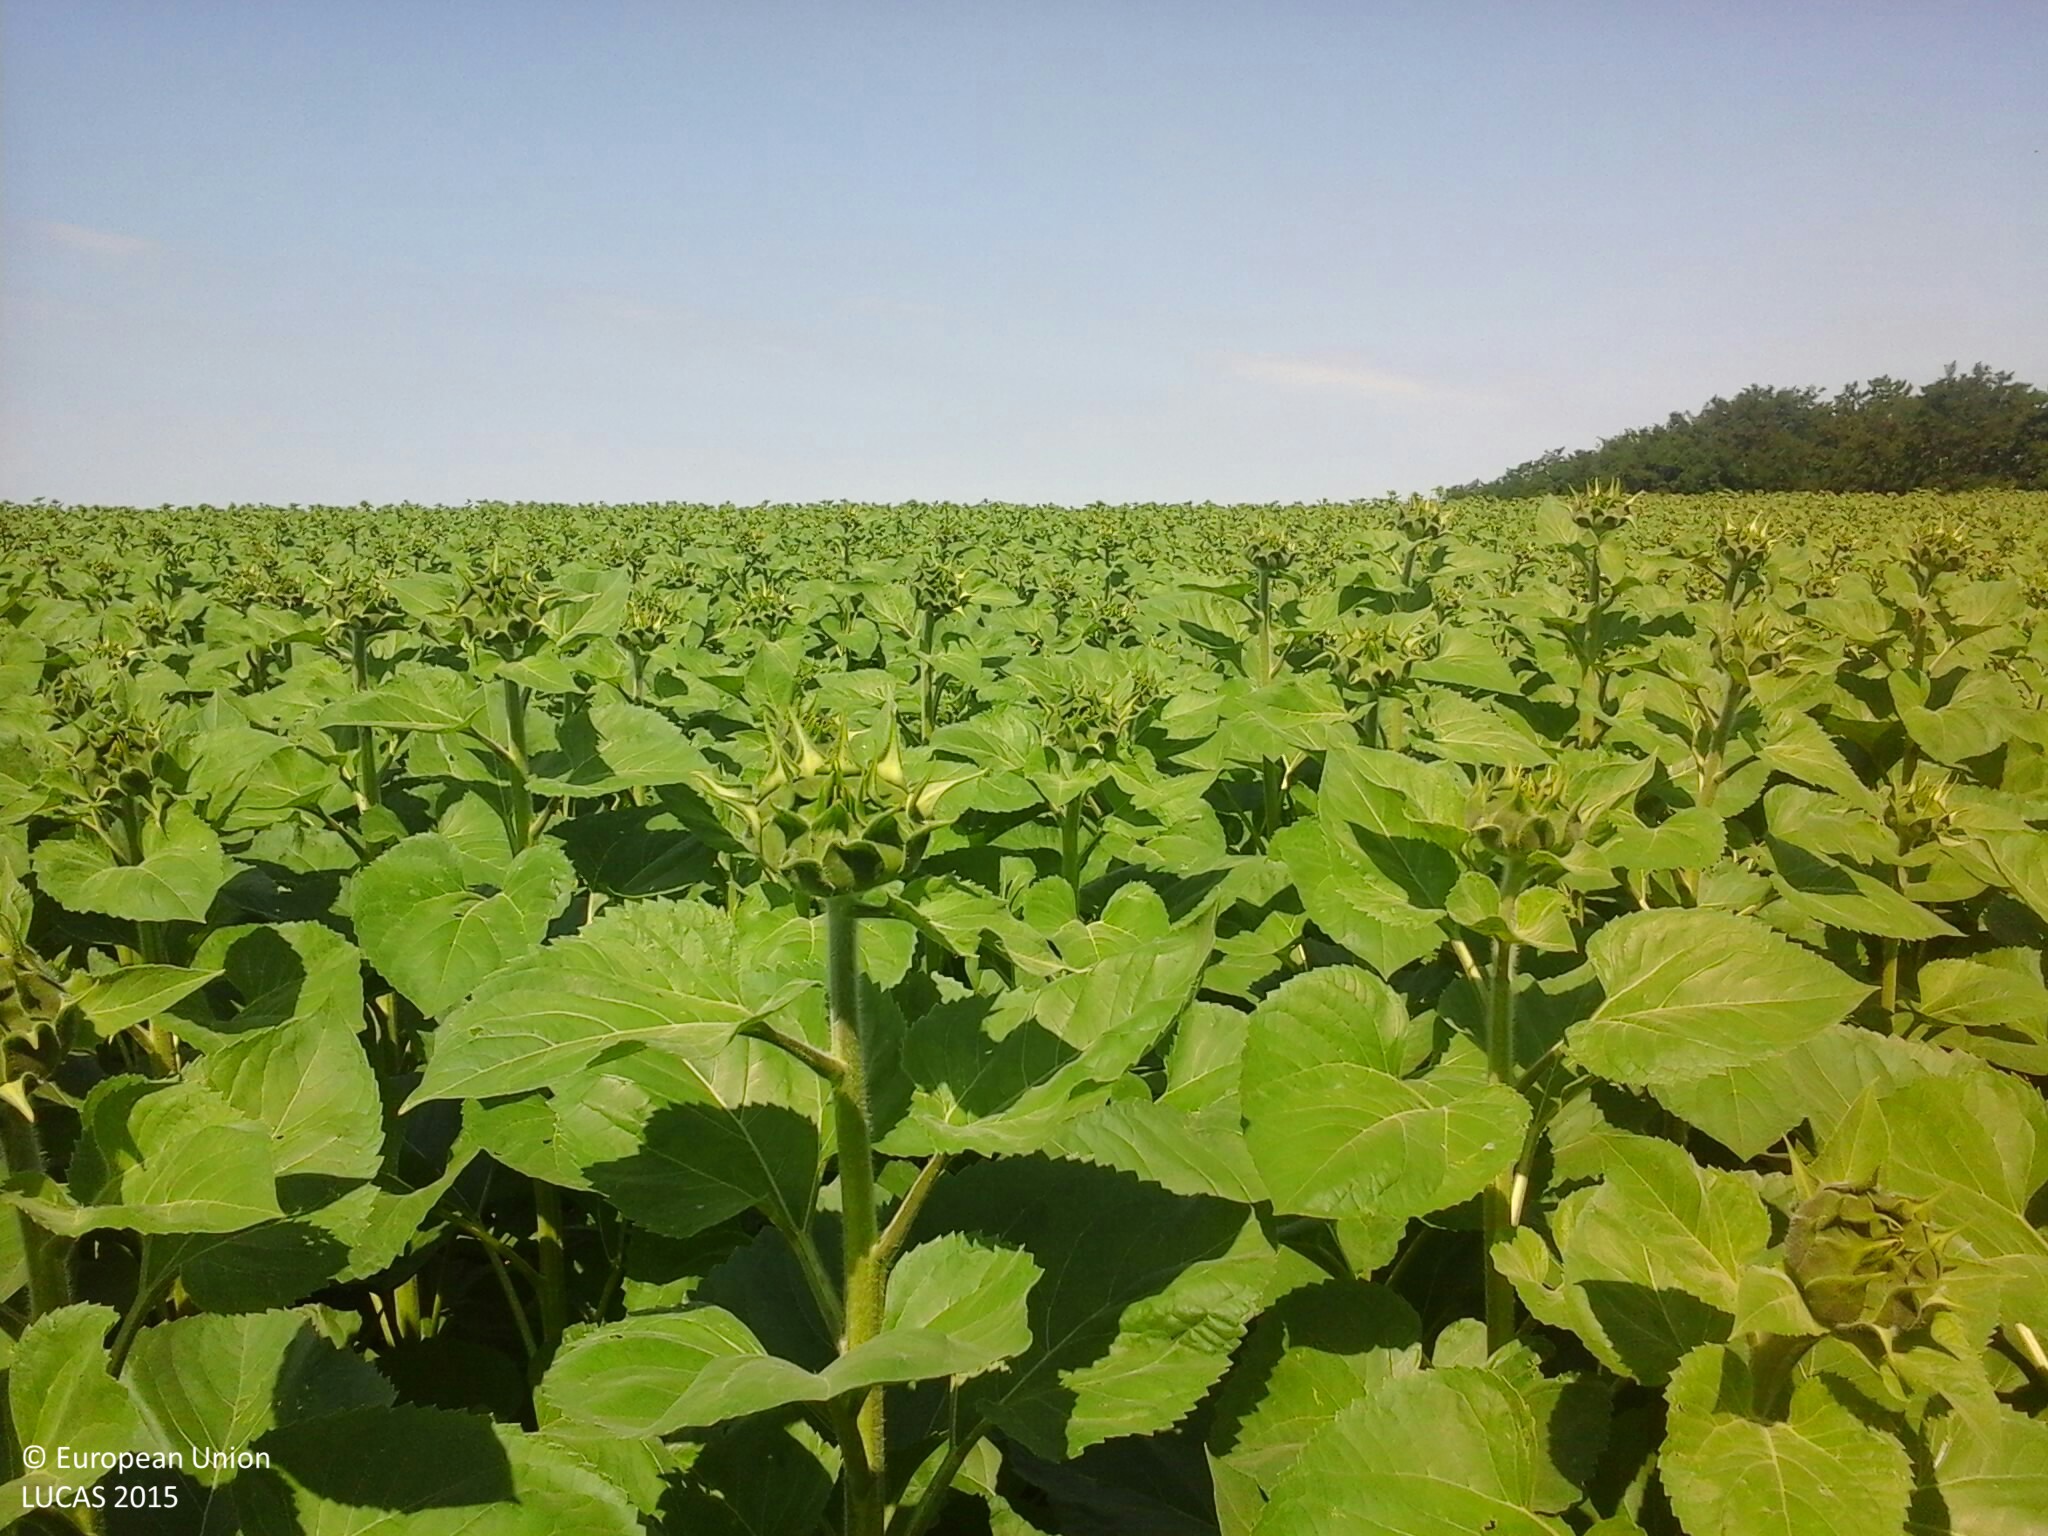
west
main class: Cropland
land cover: Sunflower
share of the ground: > 75 %
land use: Agriculture (excluding fallow land and kitchen gardens)
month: July
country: HU
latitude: 47.8603
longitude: 21.7978
